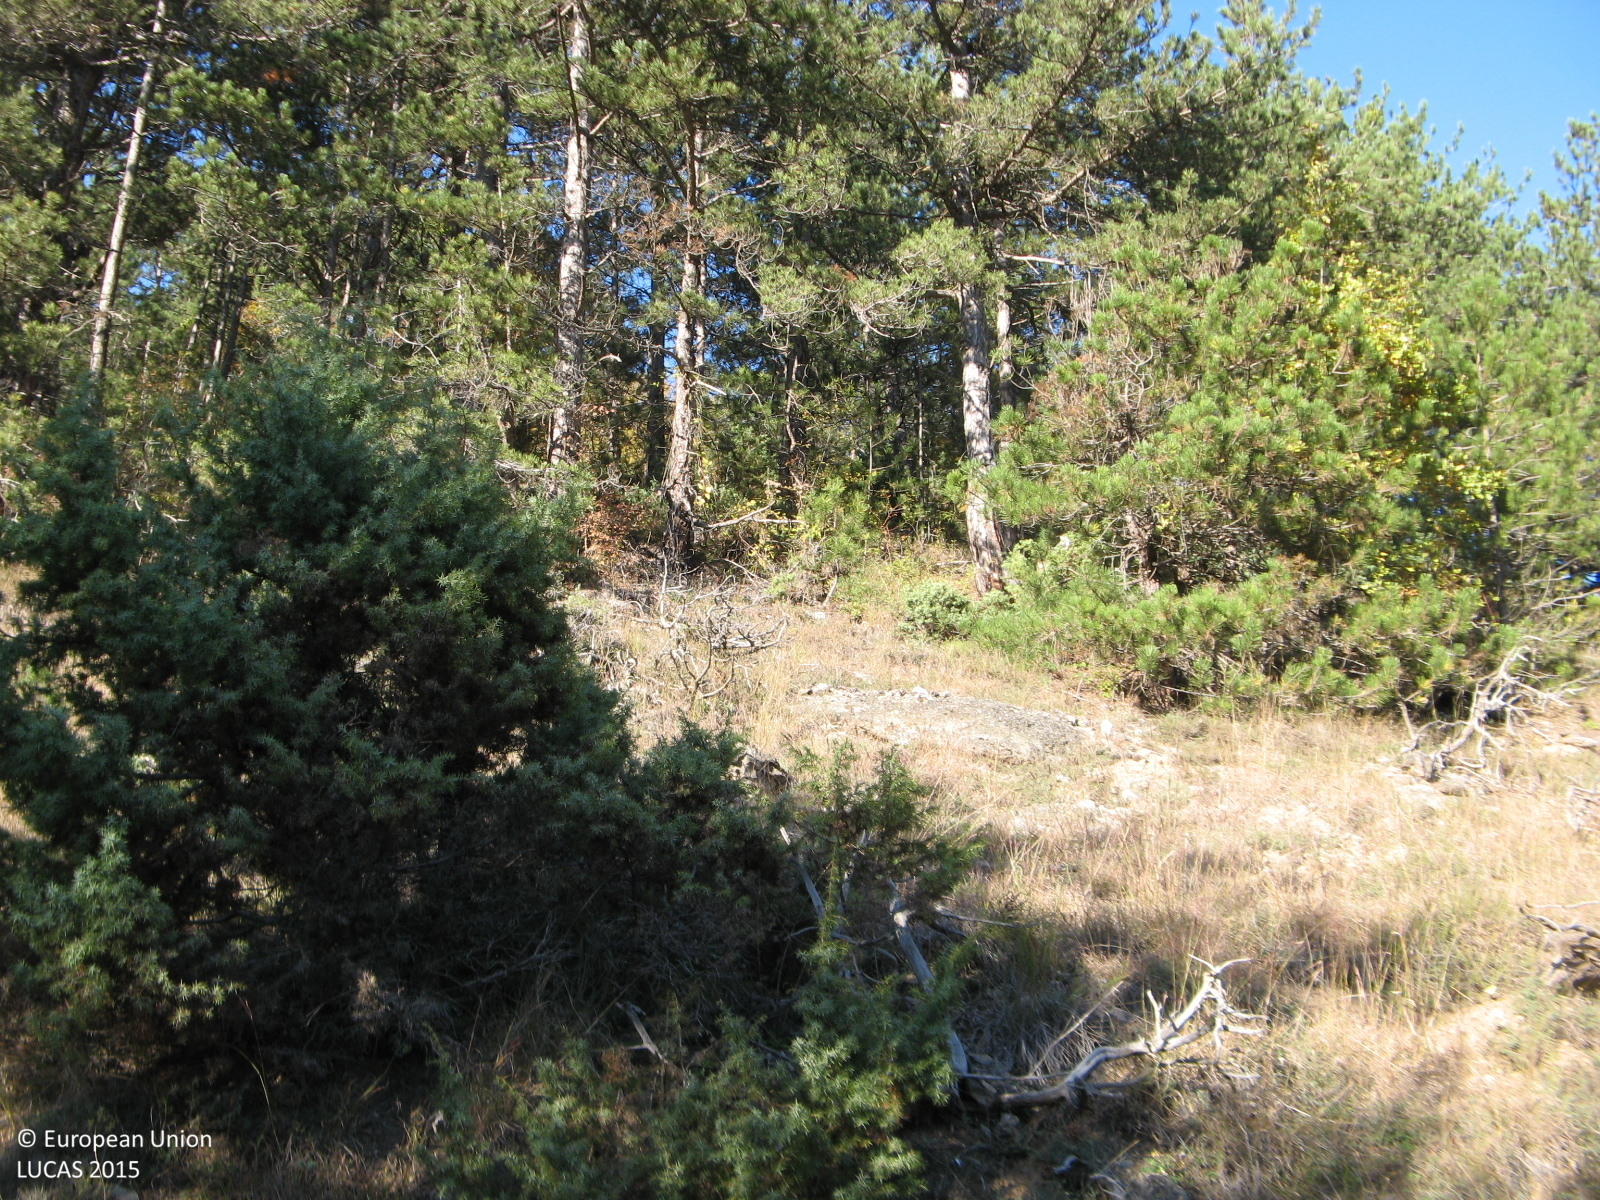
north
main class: Woodland
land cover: Pine dominated coniferous woodland
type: hemiboreal forest and nemoral coniferous forest and mixed broadleaved-coniferous forest
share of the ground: 50 - 75 %
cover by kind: coniferous forest trees 70 %, unconsolidated bare surface 15 %, herbaceous plants 10 %, shrubs 5 %
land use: Forestry
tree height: > 5 m
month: October
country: BG
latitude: 41.8524
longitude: 24.6815
